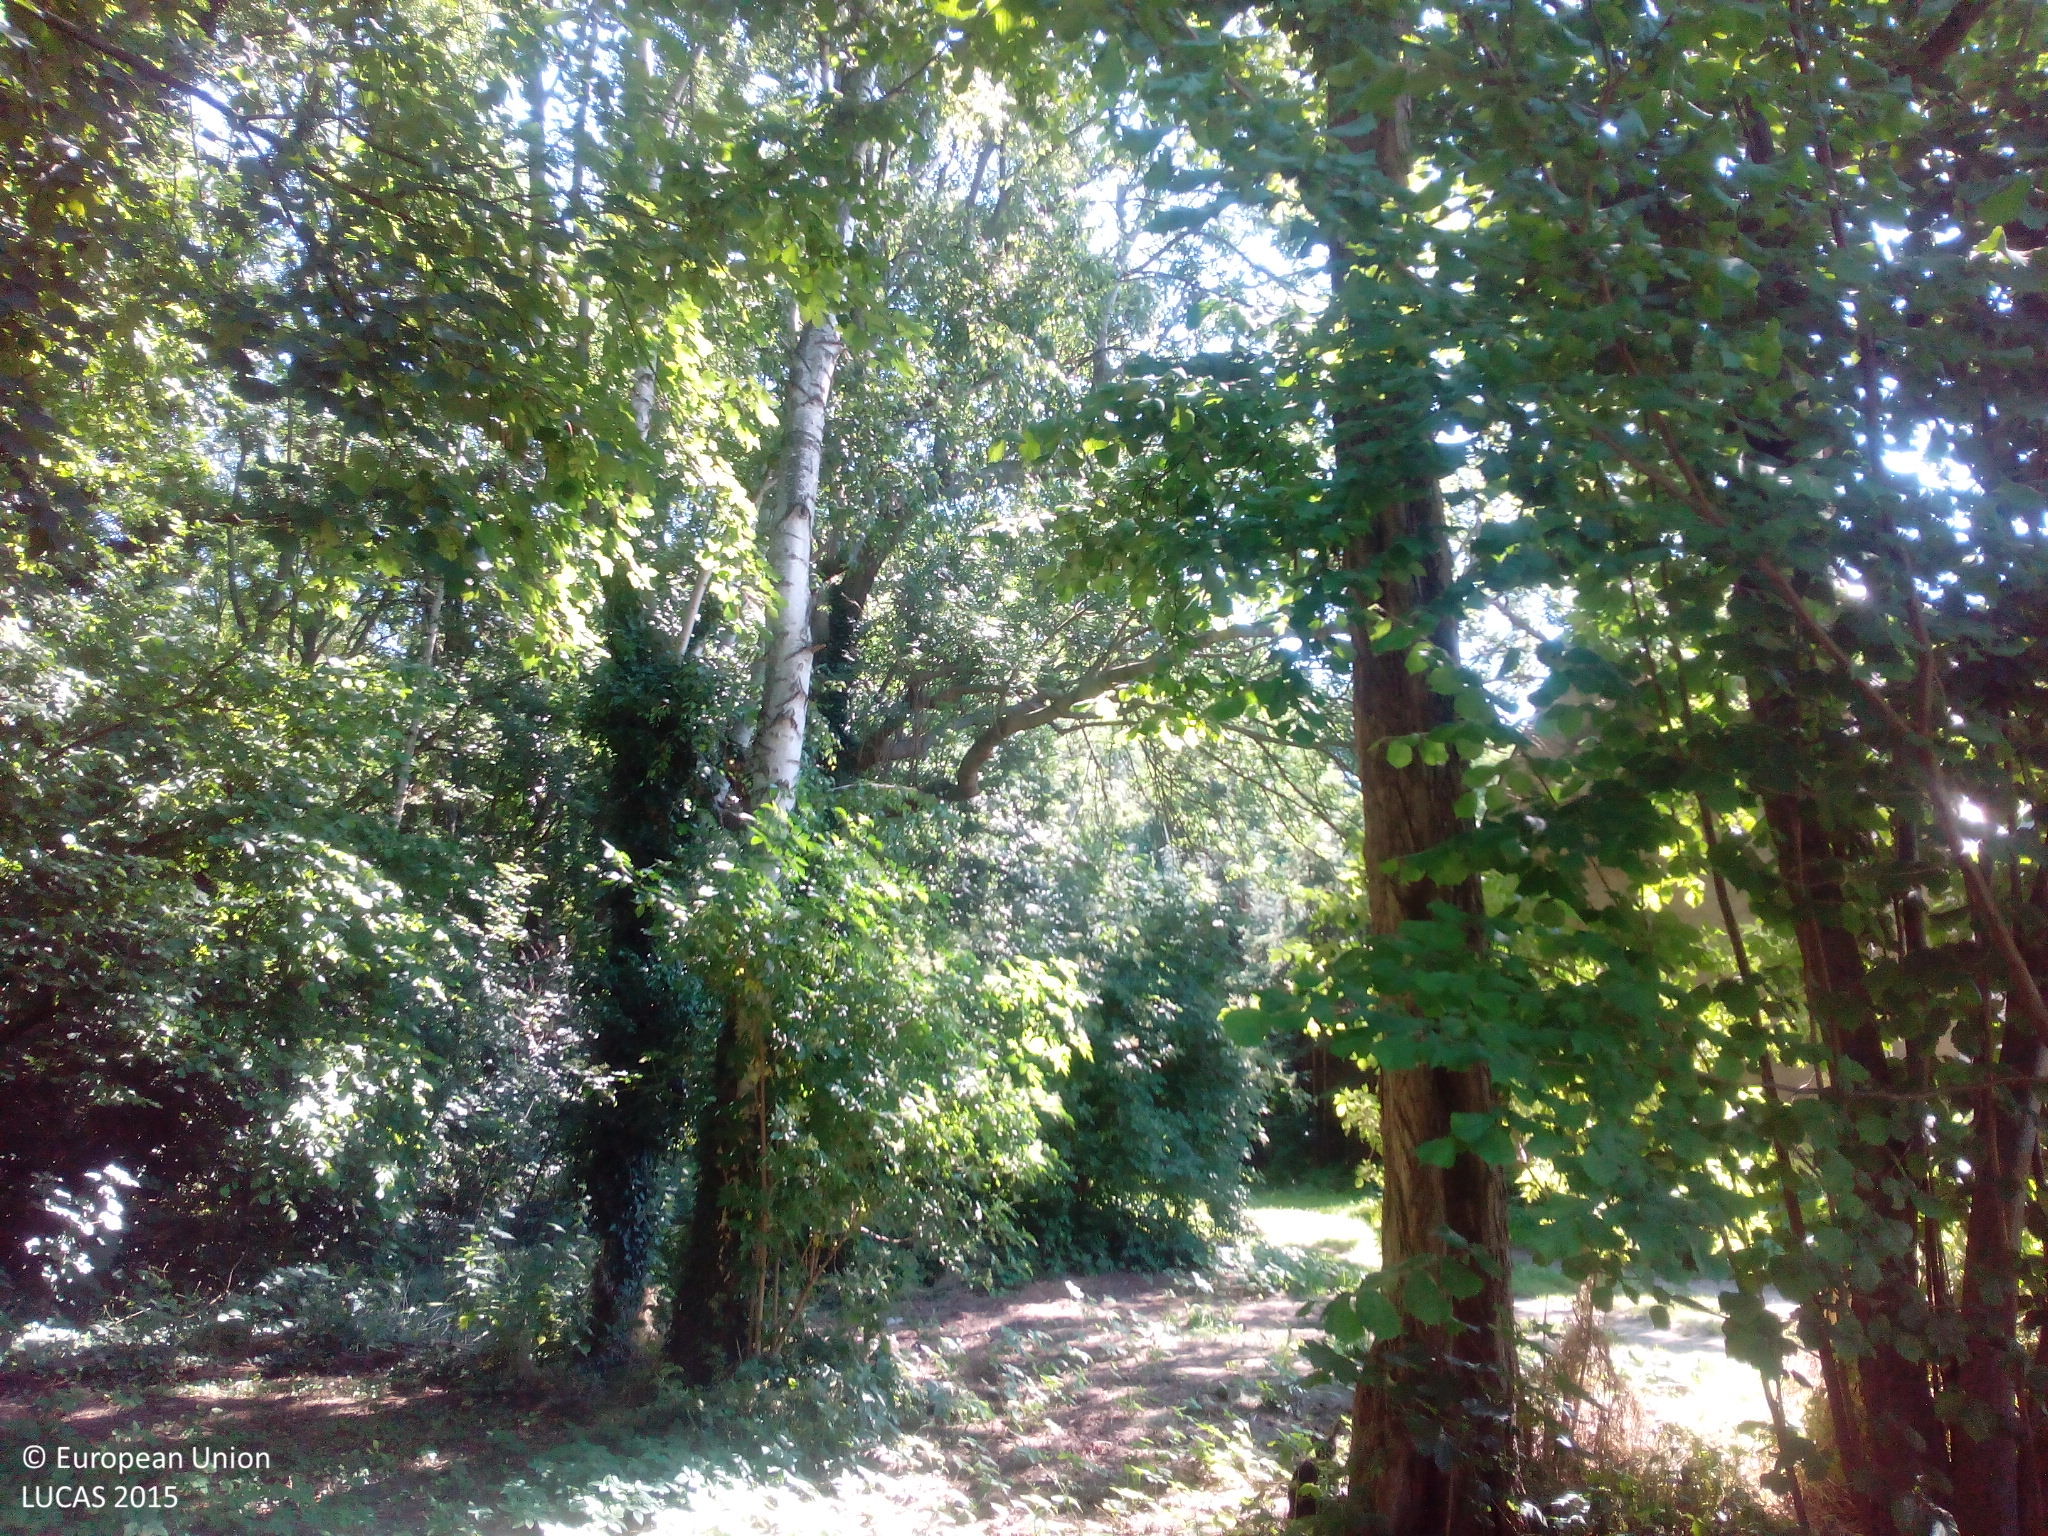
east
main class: Woodland
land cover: Broadleaved woodland
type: mesophytic deciduous forest
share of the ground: > 75 %
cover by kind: broadleaved forest trees 90 %, herbaceous plants 10 %
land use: Forestry
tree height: > 5 m
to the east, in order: Broadleaved woodland; Grassland without tree/shrub cover; Artificial constructions in urban areas
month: July
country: DE
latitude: 51.2574
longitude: 13.1096
